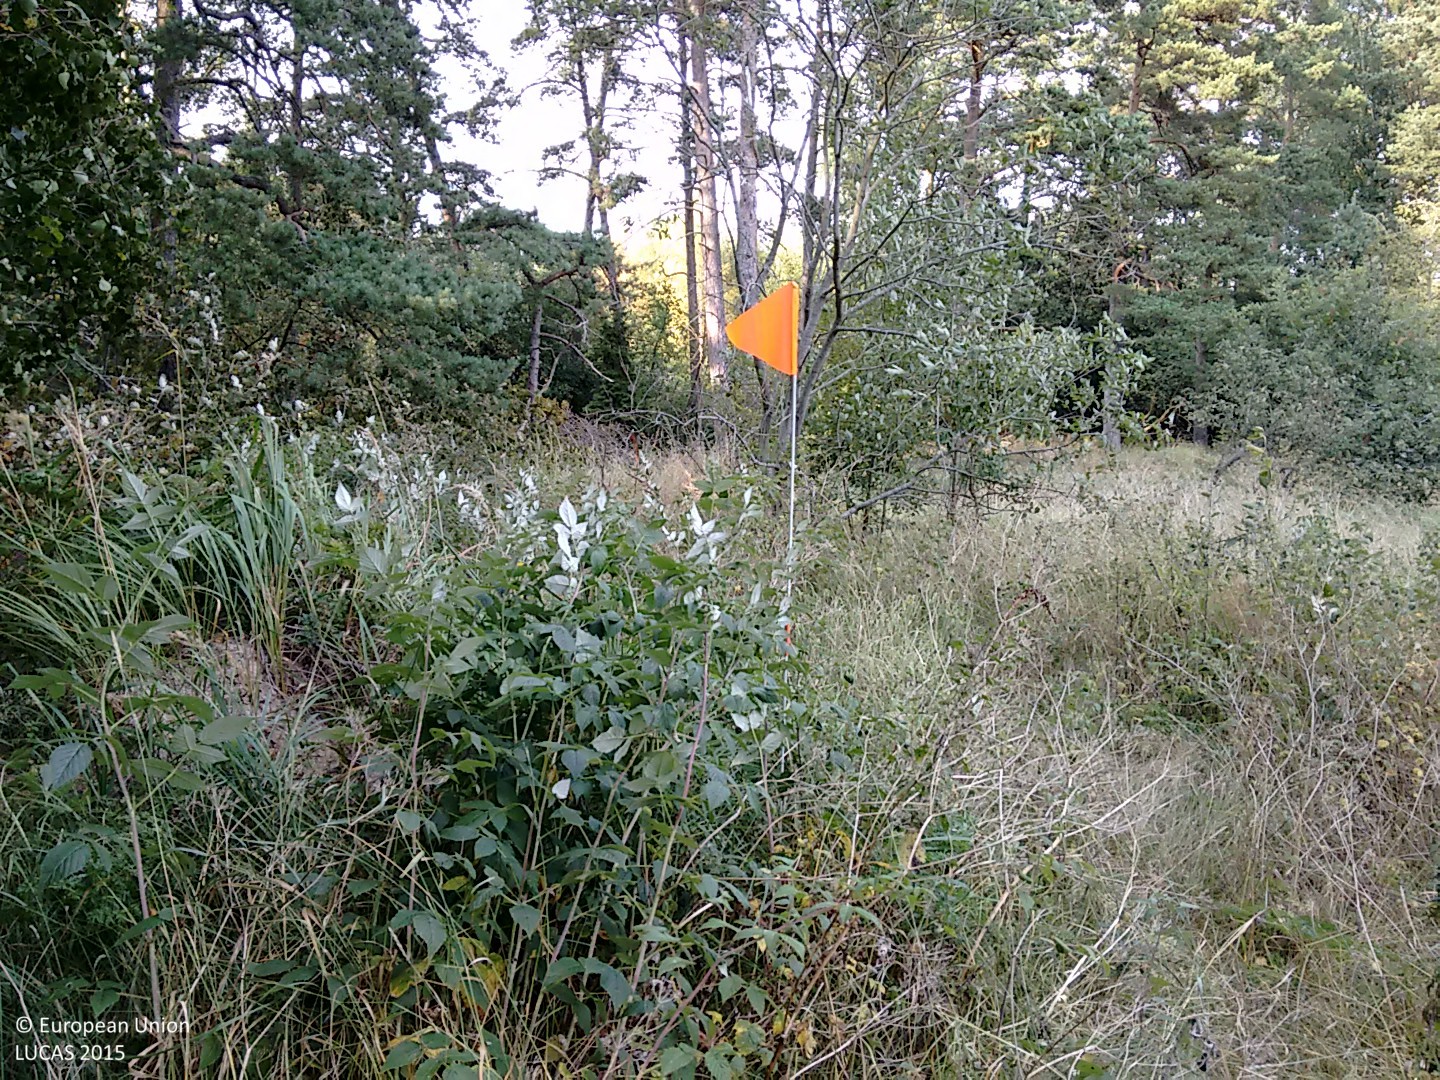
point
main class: Woodland
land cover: Pine dominated mixed woodland
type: hemiboreal forest and nemoral coniferous forest and mixed broadleaved-coniferous forest
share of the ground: > 75 %
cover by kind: coniferous forest trees 65 %, broadleaved forest trees 30 %, herbaceous plants 5 %
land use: Forestry
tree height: > 5 m
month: August
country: FI
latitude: 60.0465
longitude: 20.4439
